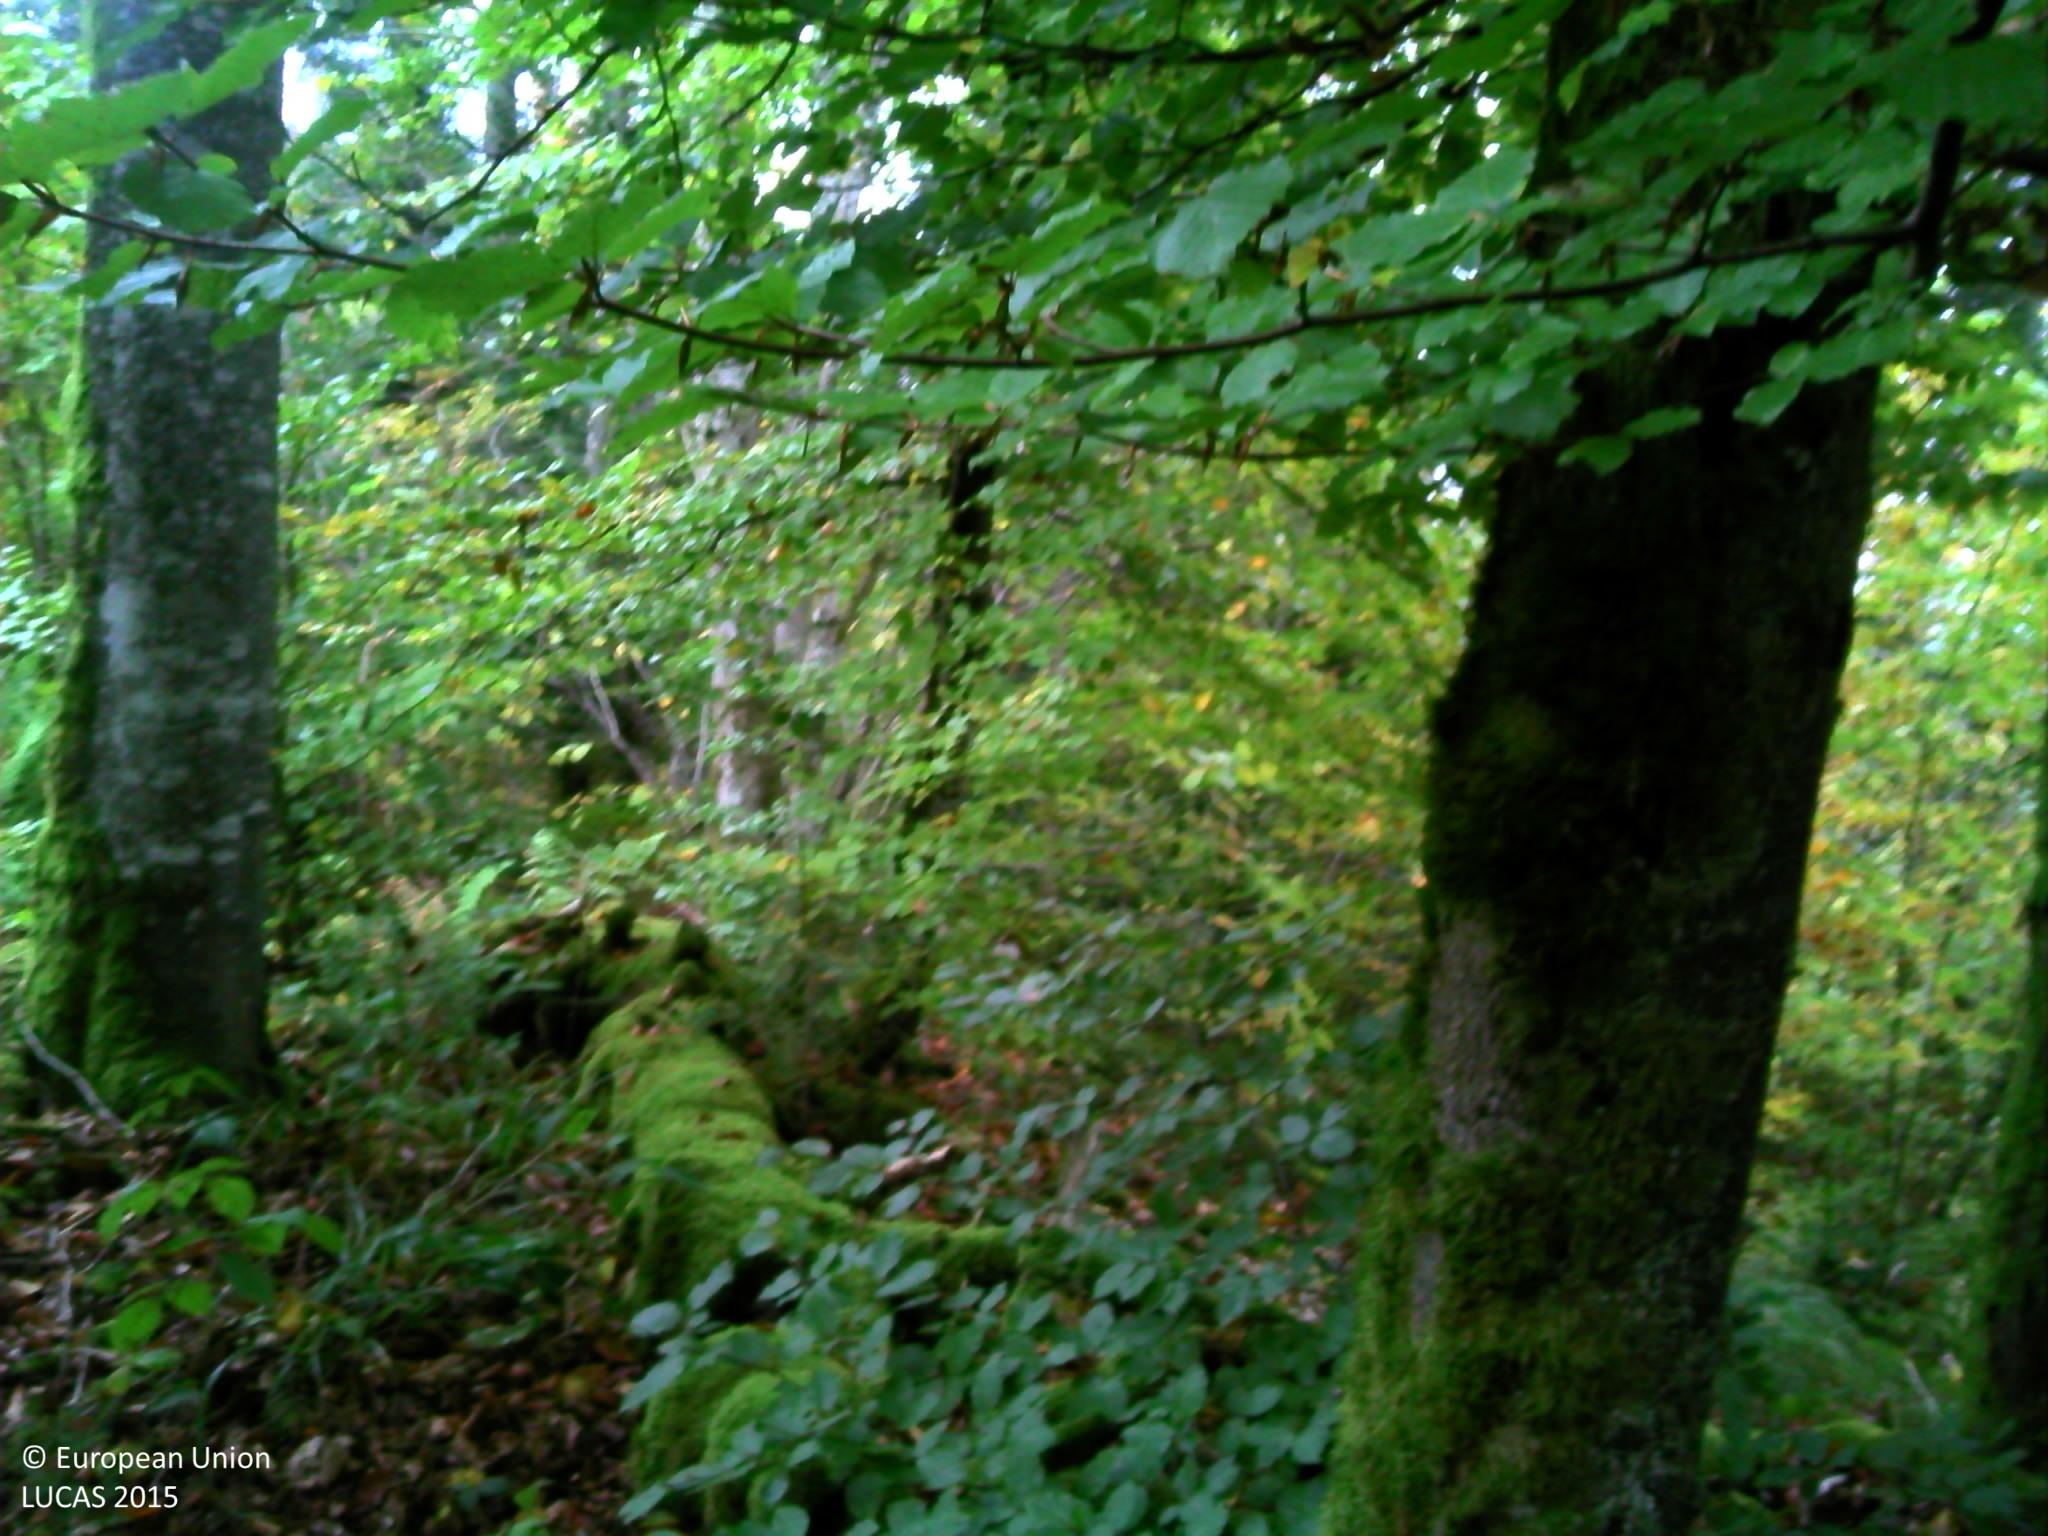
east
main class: Woodland
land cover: Spruce dominated mixed woodland
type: mountainous beech forest
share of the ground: > 75 %
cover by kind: broadleaved forest trees 60 %, coniferous forest trees 30 %, shrubs 5 %, unconsolidated bare surface 5 %
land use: Forestry
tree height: > 5 m
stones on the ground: < 10 %
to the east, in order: Spruce dominated mixed woodland; Tracks; Spontaneously vegetated surfaces; Spruce dominated mixed woodland; Tracks; Spruce dominated mixed woodland; Spontaneously vegetated surfaces; Tracks; Spruce dominated mixed woodland
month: October
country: FR
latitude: 46.8942
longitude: 6.1304
